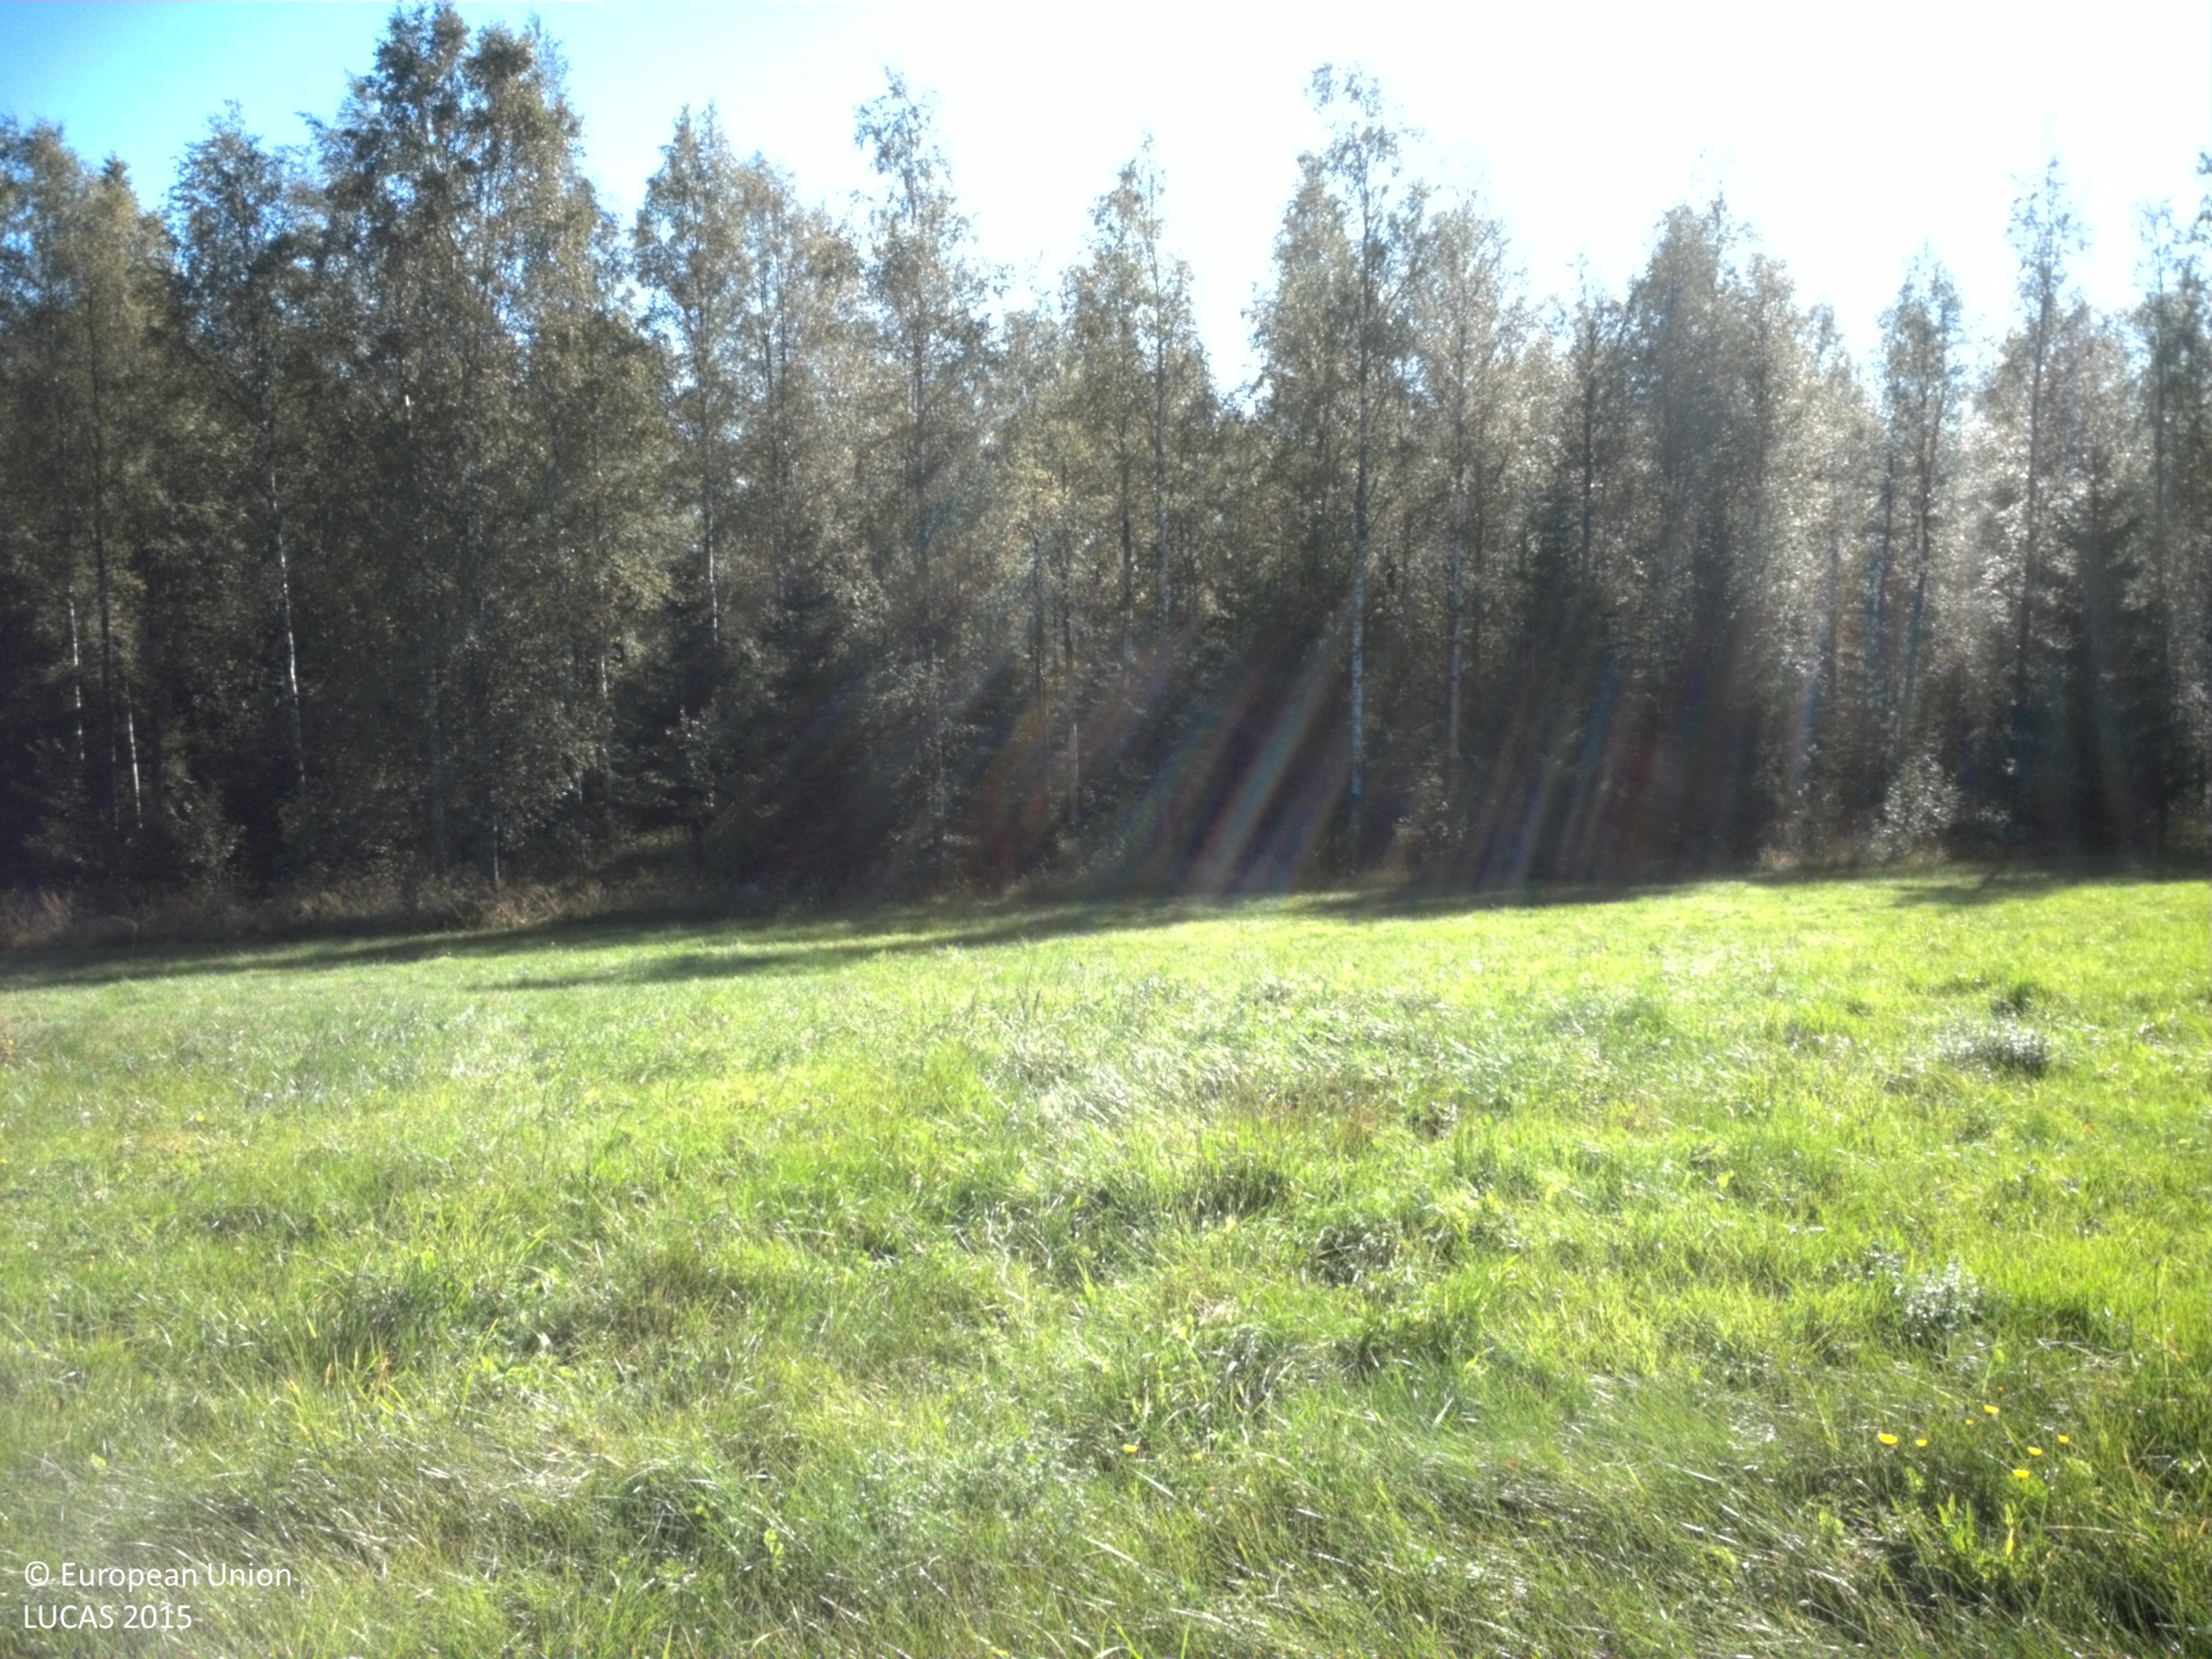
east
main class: Grassland
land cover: Grassland without tree/shrub cover
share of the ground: > 75 %
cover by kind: herbaceous plants 100 %
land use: Agriculture (excluding fallow land and kitchen gardens)
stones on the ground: < 10 %
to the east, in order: Grassland without tree/shrub cover; Spruce dominated mixed woodland; Dry stone walls; Grassland without tree/shrub cover; Broadleaved woodland; Pine dominated coniferous woodland
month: August
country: SE
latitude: 59.8493
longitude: 14.1491
